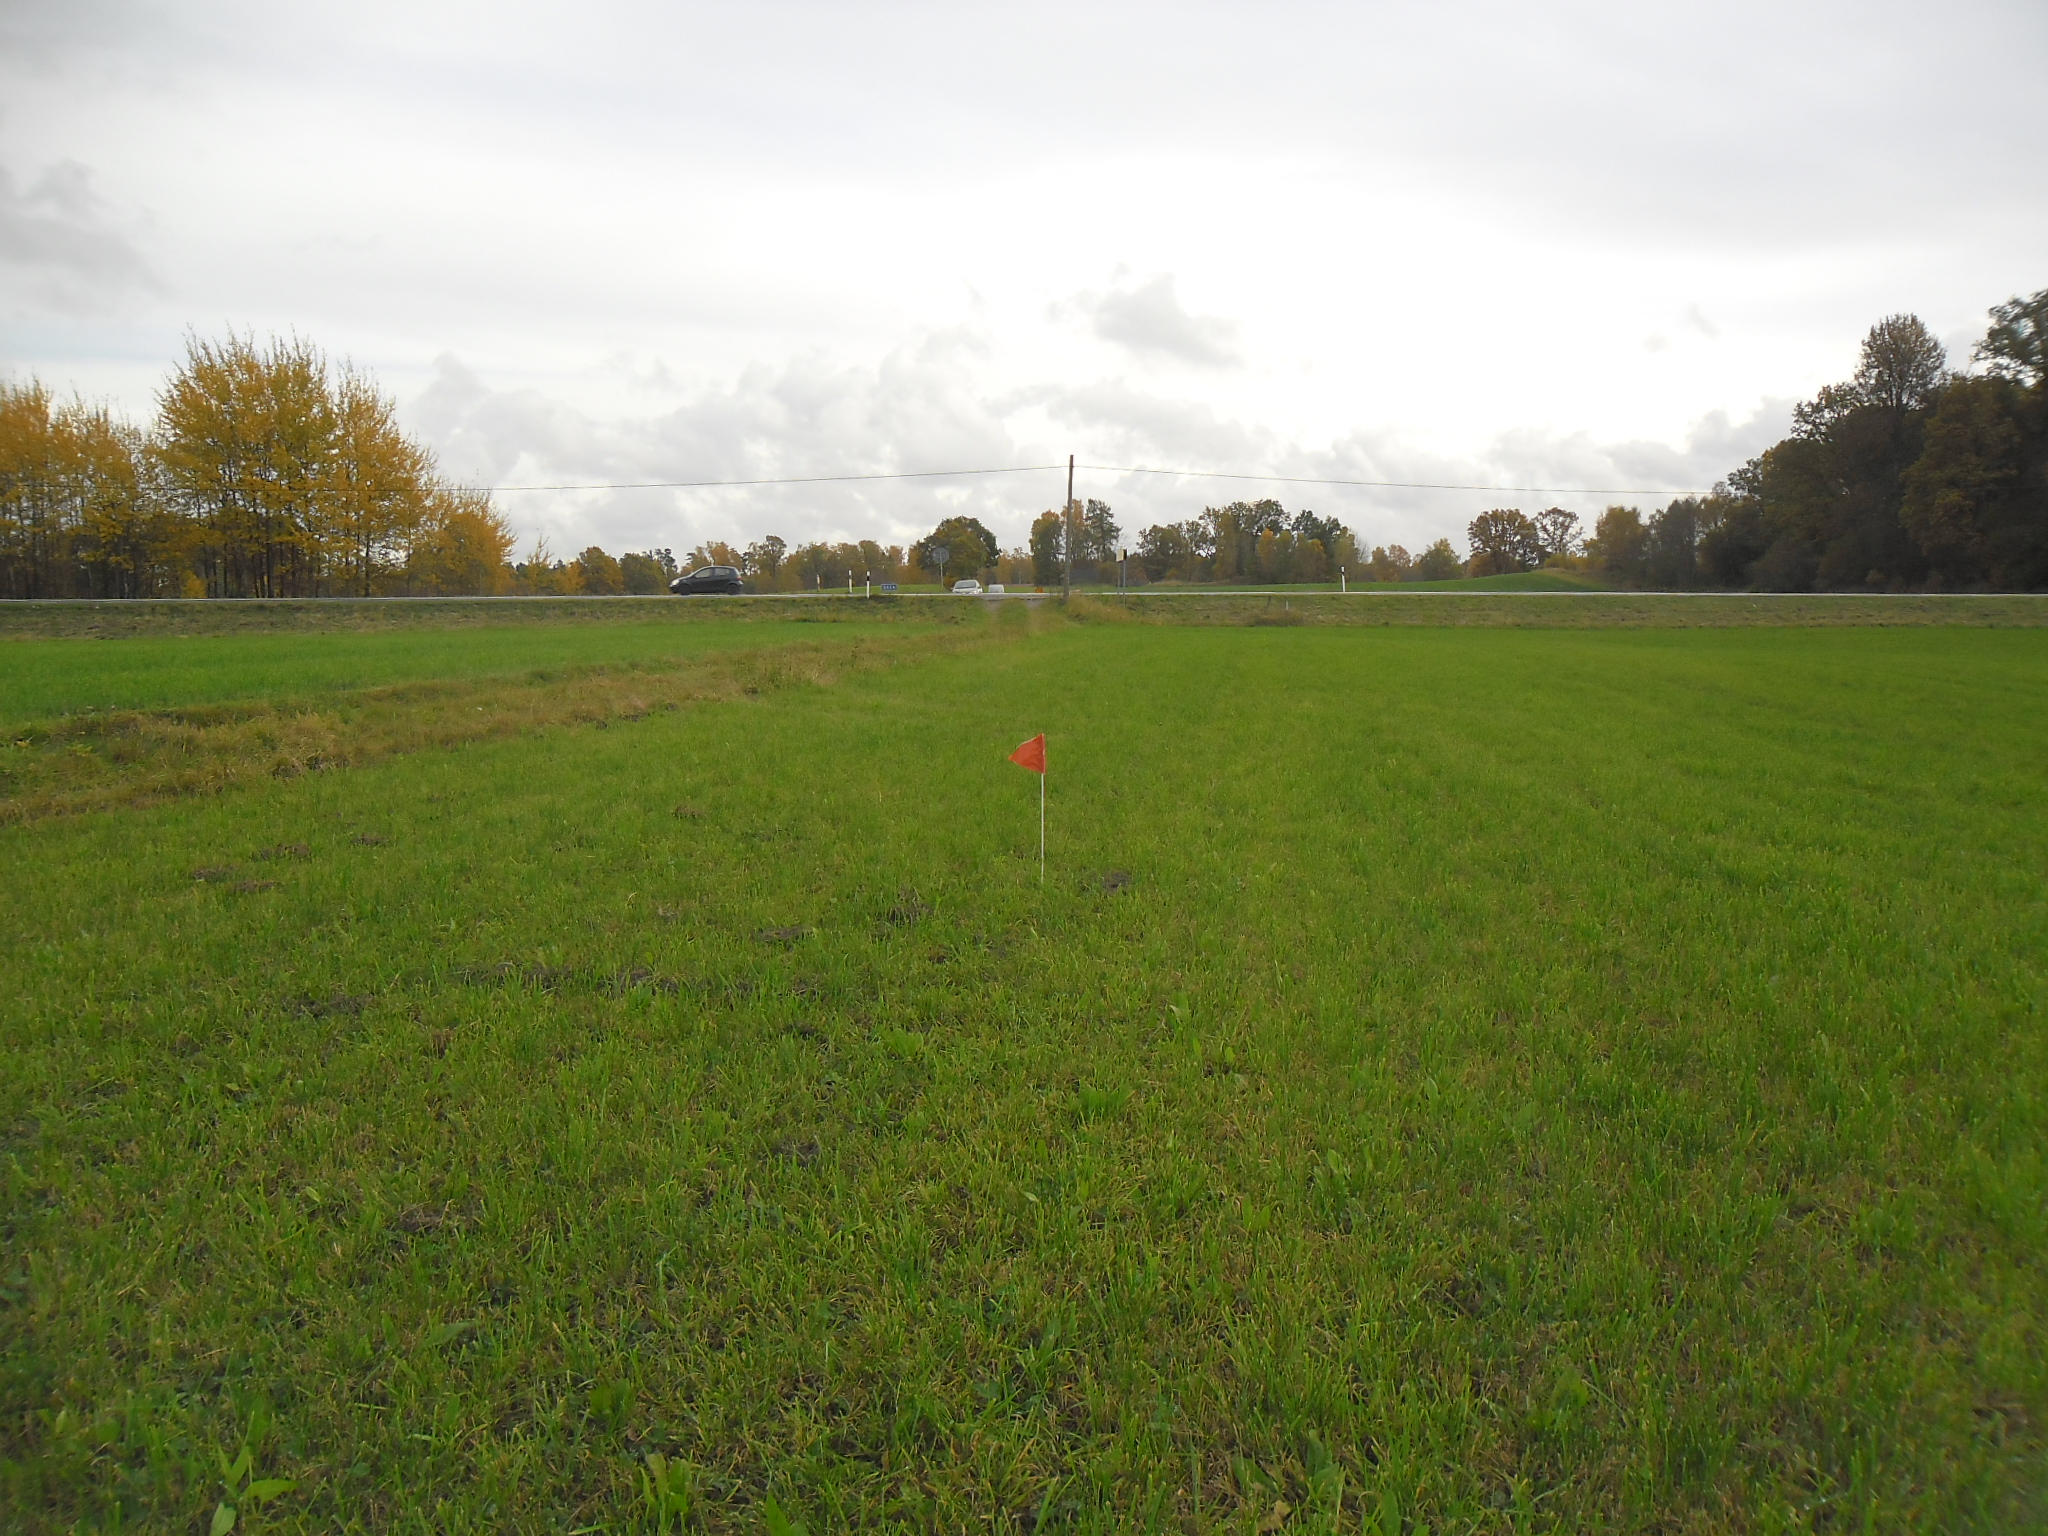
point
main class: Grassland
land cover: Grassland without tree/shrub cover
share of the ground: > 75 %
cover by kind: herbaceous plants 100 %
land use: Agriculture (excluding fallow land and kitchen gardens)
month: October
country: SE
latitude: 56.0443
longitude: 13.7059
